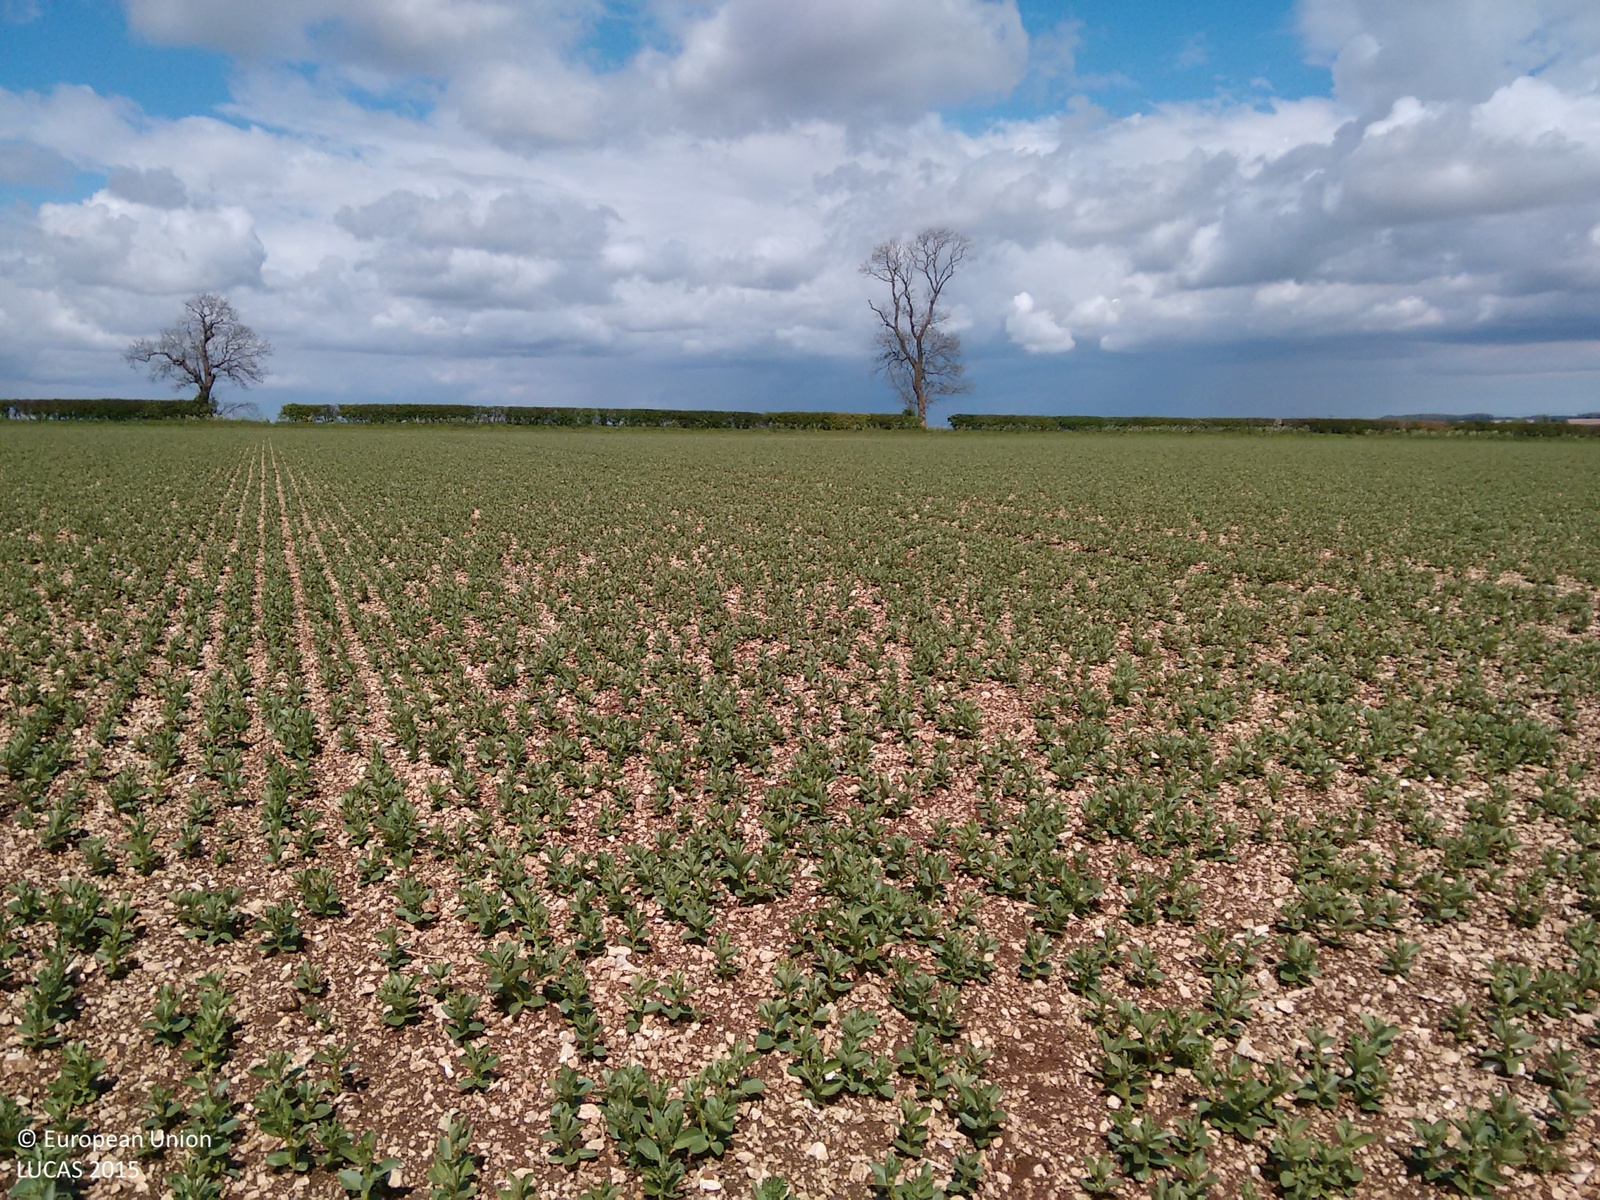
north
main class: Cropland
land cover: Dry pulses
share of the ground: 25 - 50 %
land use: Agriculture (excluding fallow land and kitchen gardens)
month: May
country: GB
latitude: 53.4240
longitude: -0.1916
